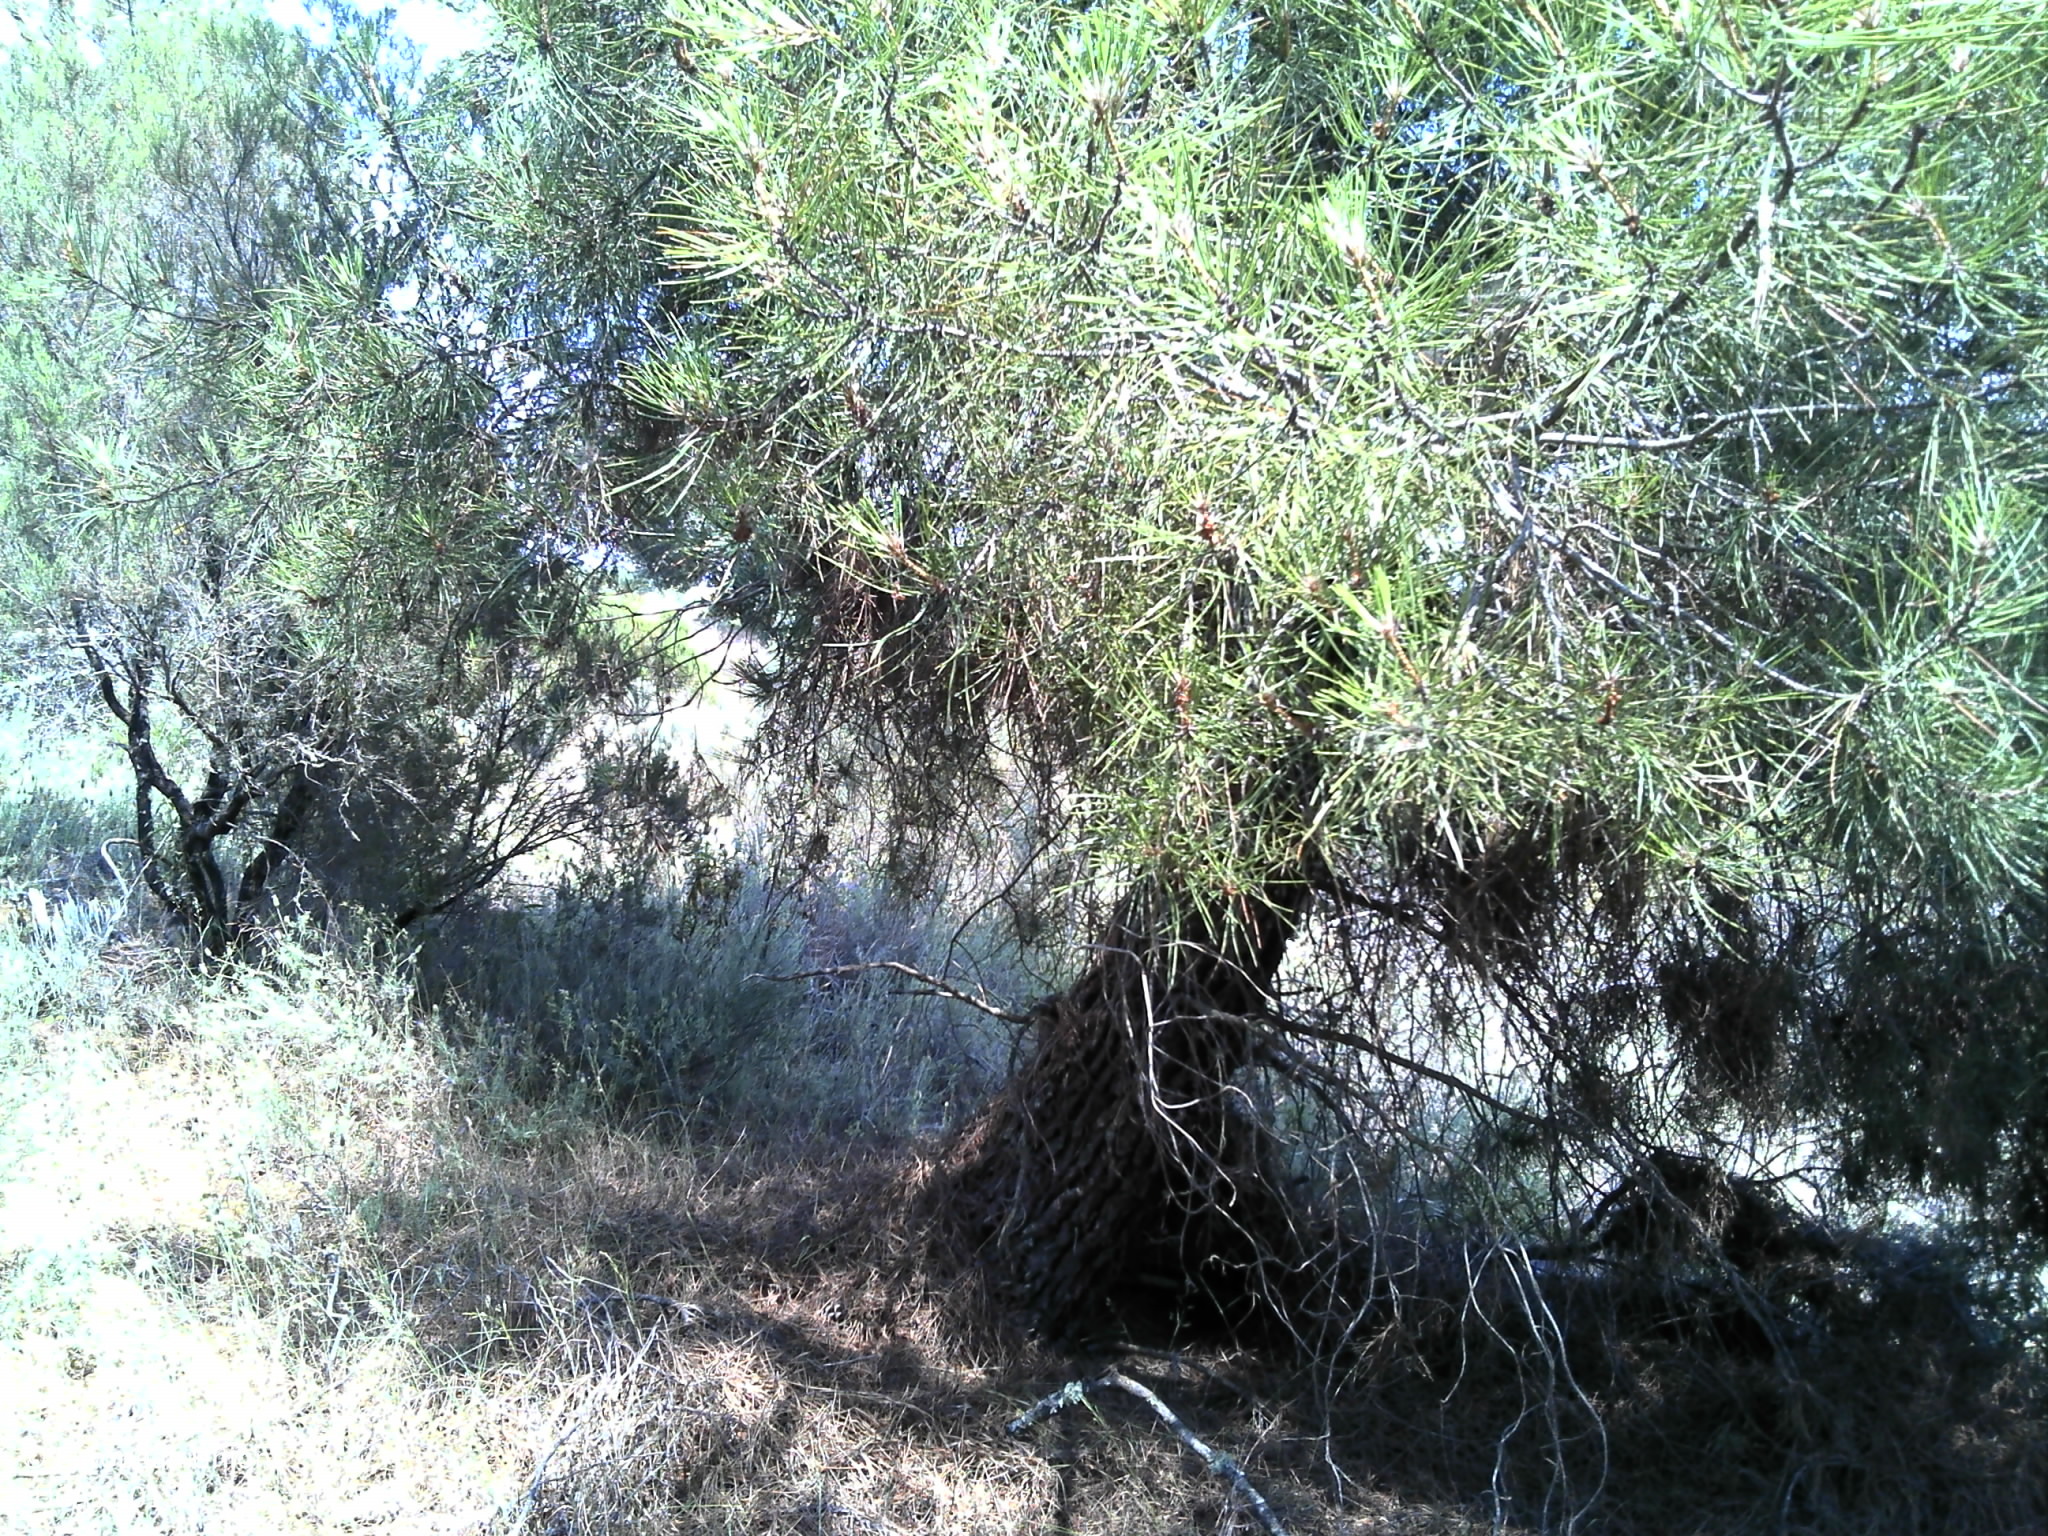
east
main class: Woodland
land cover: Pine dominated coniferous woodland
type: coniferous forest of the mediterranean region
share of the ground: 10 - 25 %
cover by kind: shrubs 80 %, coniferous forest trees 20 %
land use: Forestry
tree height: > 5 m
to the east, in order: Pine dominated coniferous woodland; Shrubland without tree cover; Pine dominated coniferous woodland; Shrubland without tree cover; Grassland with sparse tree/shrub cover; Spontaneously vegetated surfaces; Shrubland without tree cover; Ditches and canals; Shruby margins; Tracks; Shrubland without tree cover; Rocks and stones; Other bare soil; Tracks; Grass margins; Tracks; Pine dominated coniferous woodland
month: June
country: PT
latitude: 41.1879
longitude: -7.6155
